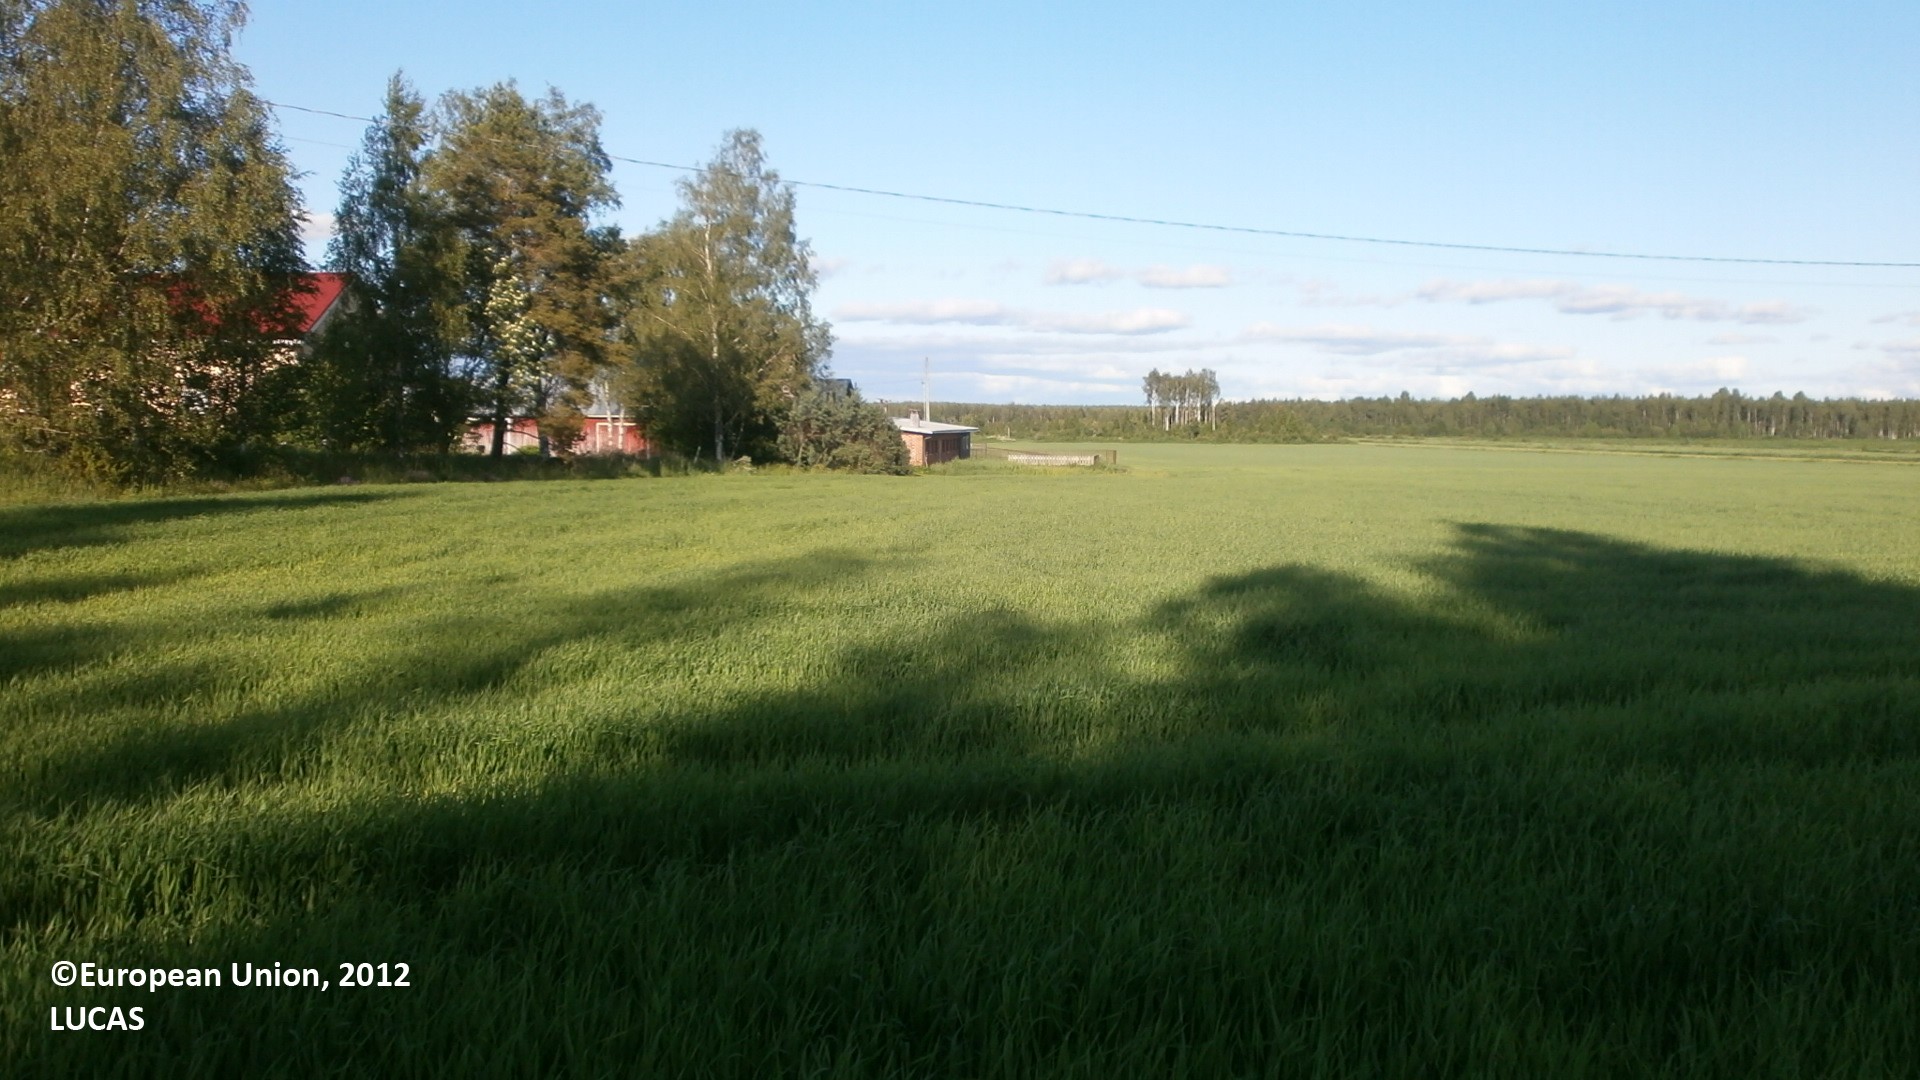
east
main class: Cropland
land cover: Barley
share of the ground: 50 - 75 %
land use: Agriculture (excluding fallow land and kitchen gardens)
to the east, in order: Barley; Electric lines; Barley; Ditches and canals; Grassland without tree/shrub cover; Artificial constructions in urban areas; Ditches and canals; Grass margins; Barley
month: June
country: FI
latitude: 64.3960
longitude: 25.0344
